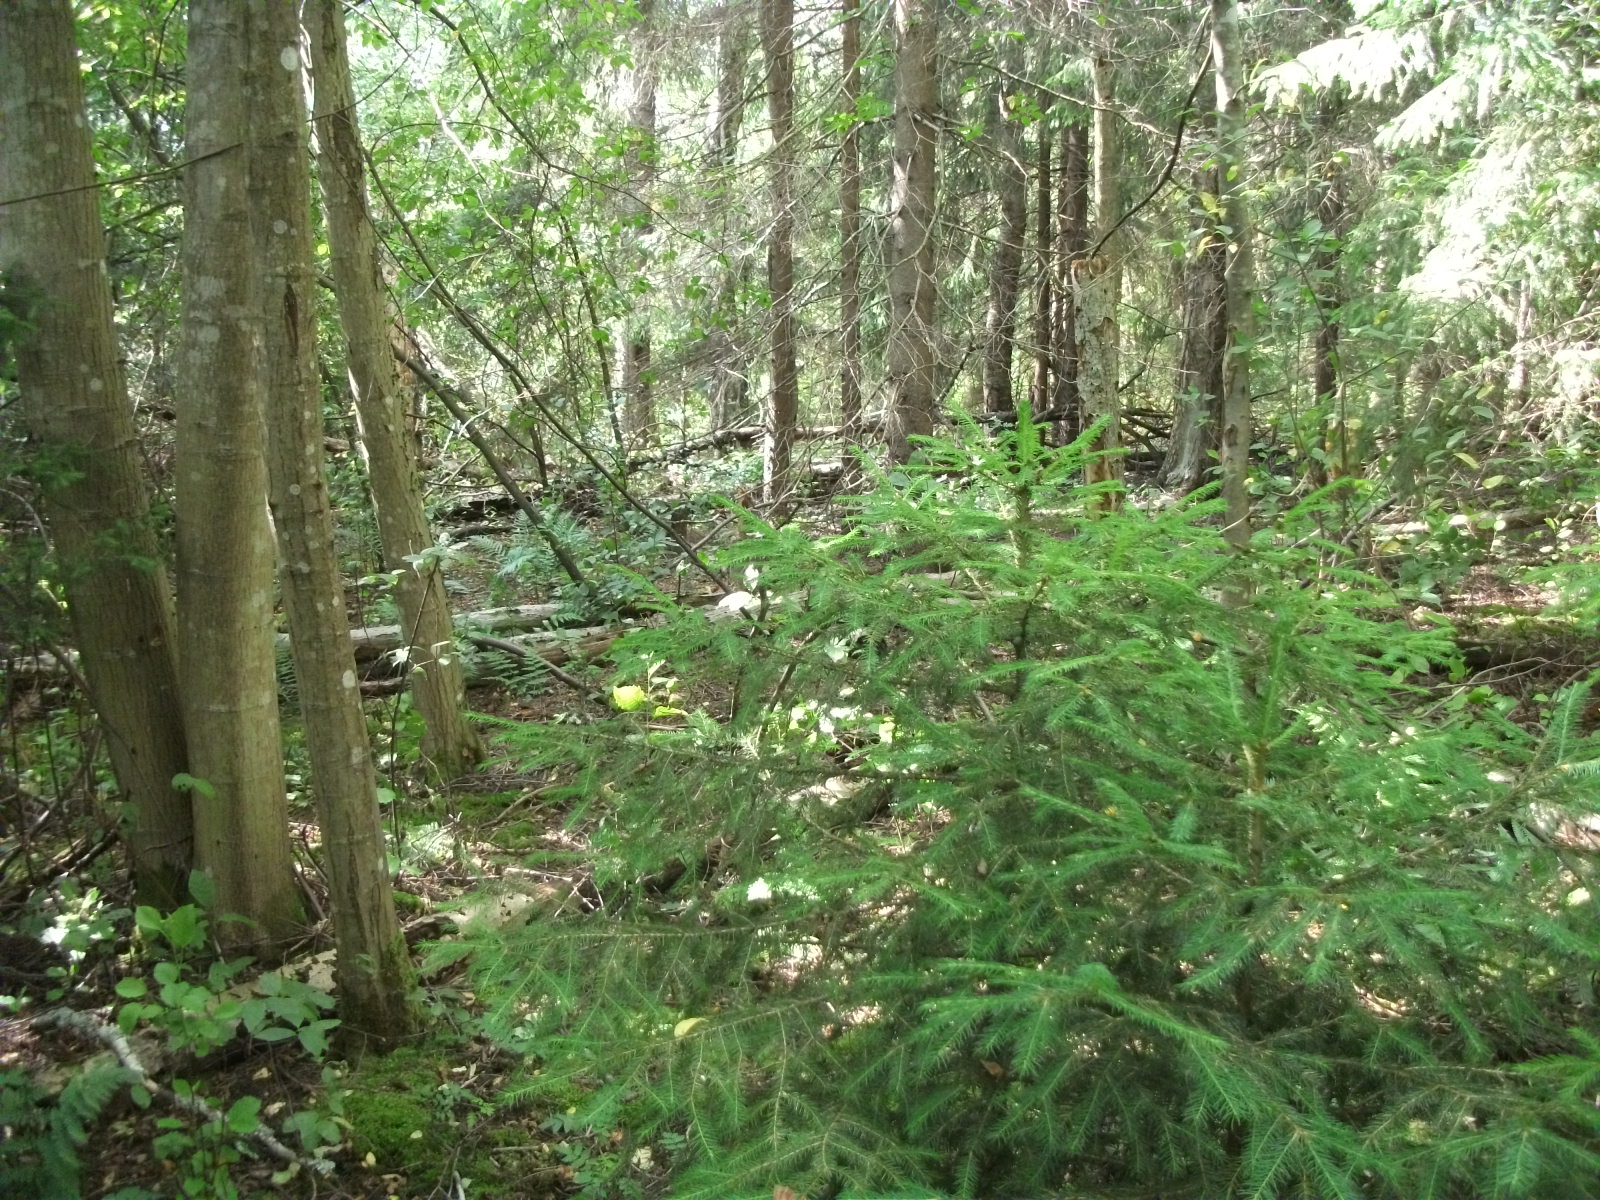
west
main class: Woodland
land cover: Spruce dominated mixed woodland
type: hemiboreal forest and nemoral coniferous forest and mixed broadleaved-coniferous forest
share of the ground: > 75 %
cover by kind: coniferous forest trees 60 %, broadleaved forest trees 30 %, herbaceous plants 10 %
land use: Forestry
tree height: > 5 m
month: July
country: LV
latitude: 57.1301
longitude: 25.9387
